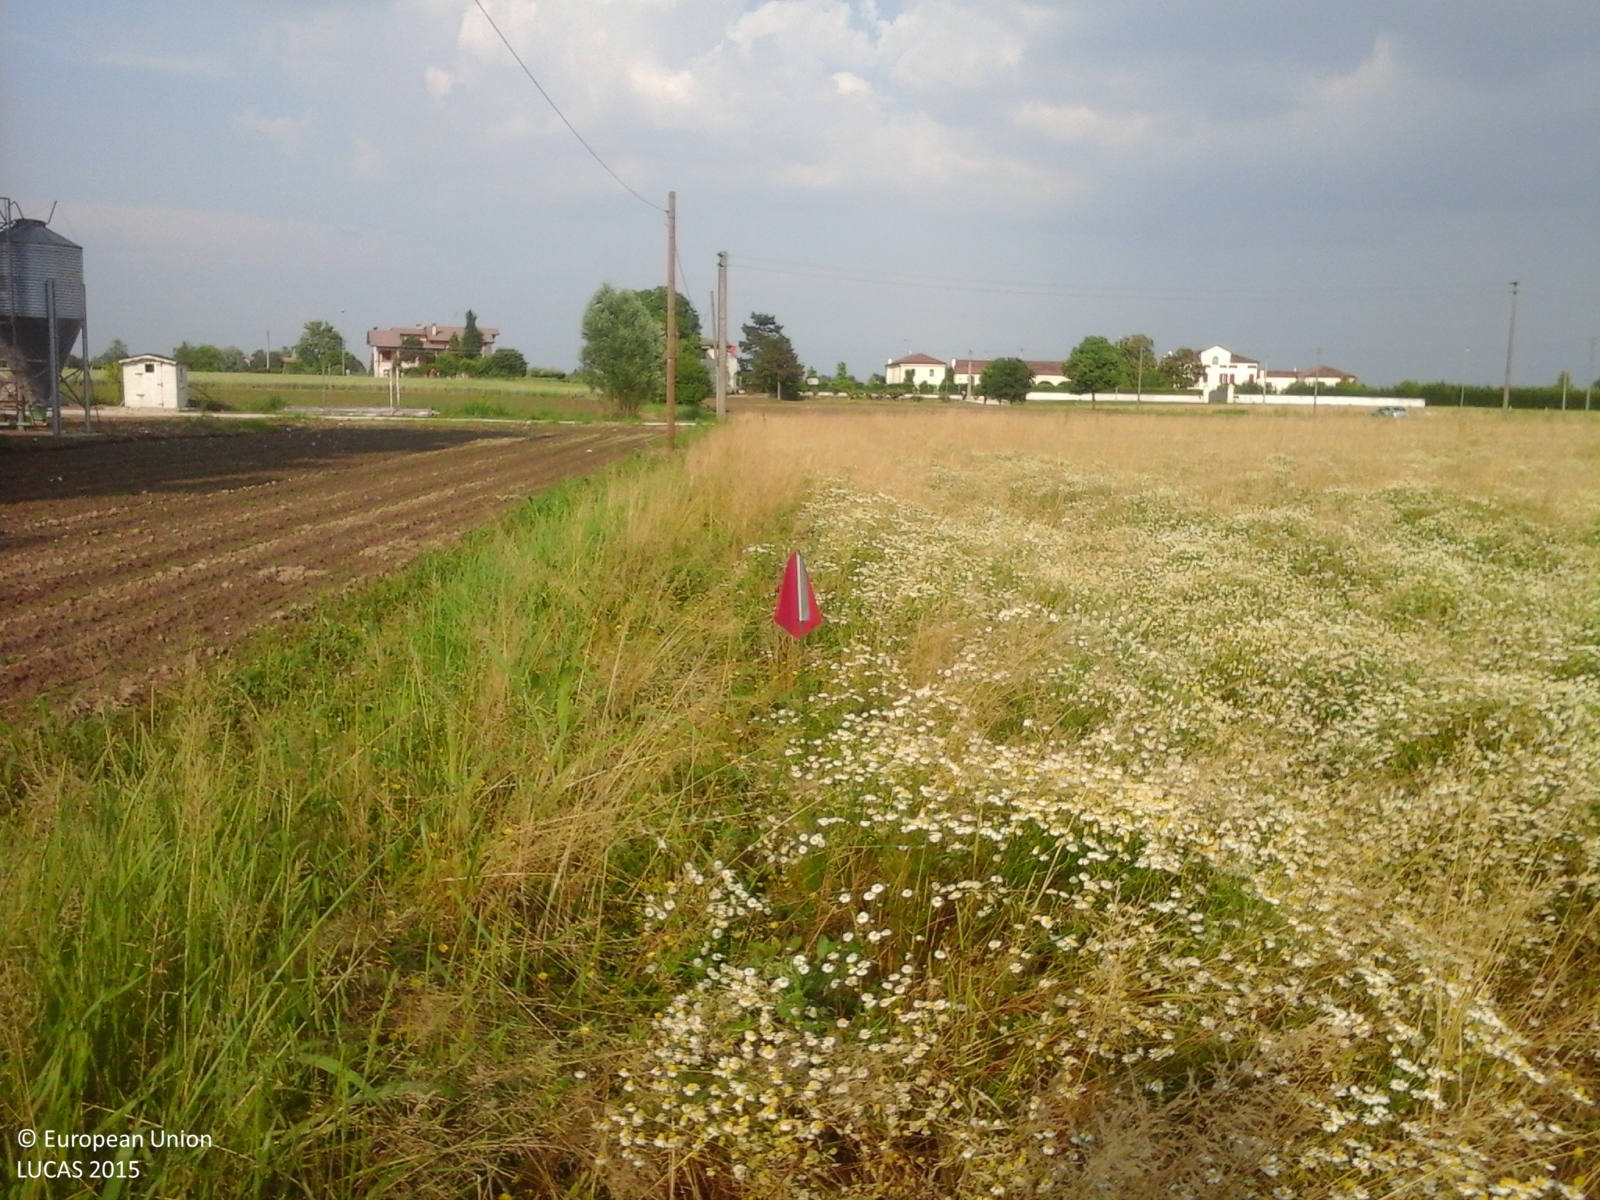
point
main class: Grassland
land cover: Spontaneously vegetated surfaces
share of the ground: > 75 %
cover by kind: herbaceous plants 100 %
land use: Fallow land
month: May
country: IT
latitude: 45.4539
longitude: 11.7490
